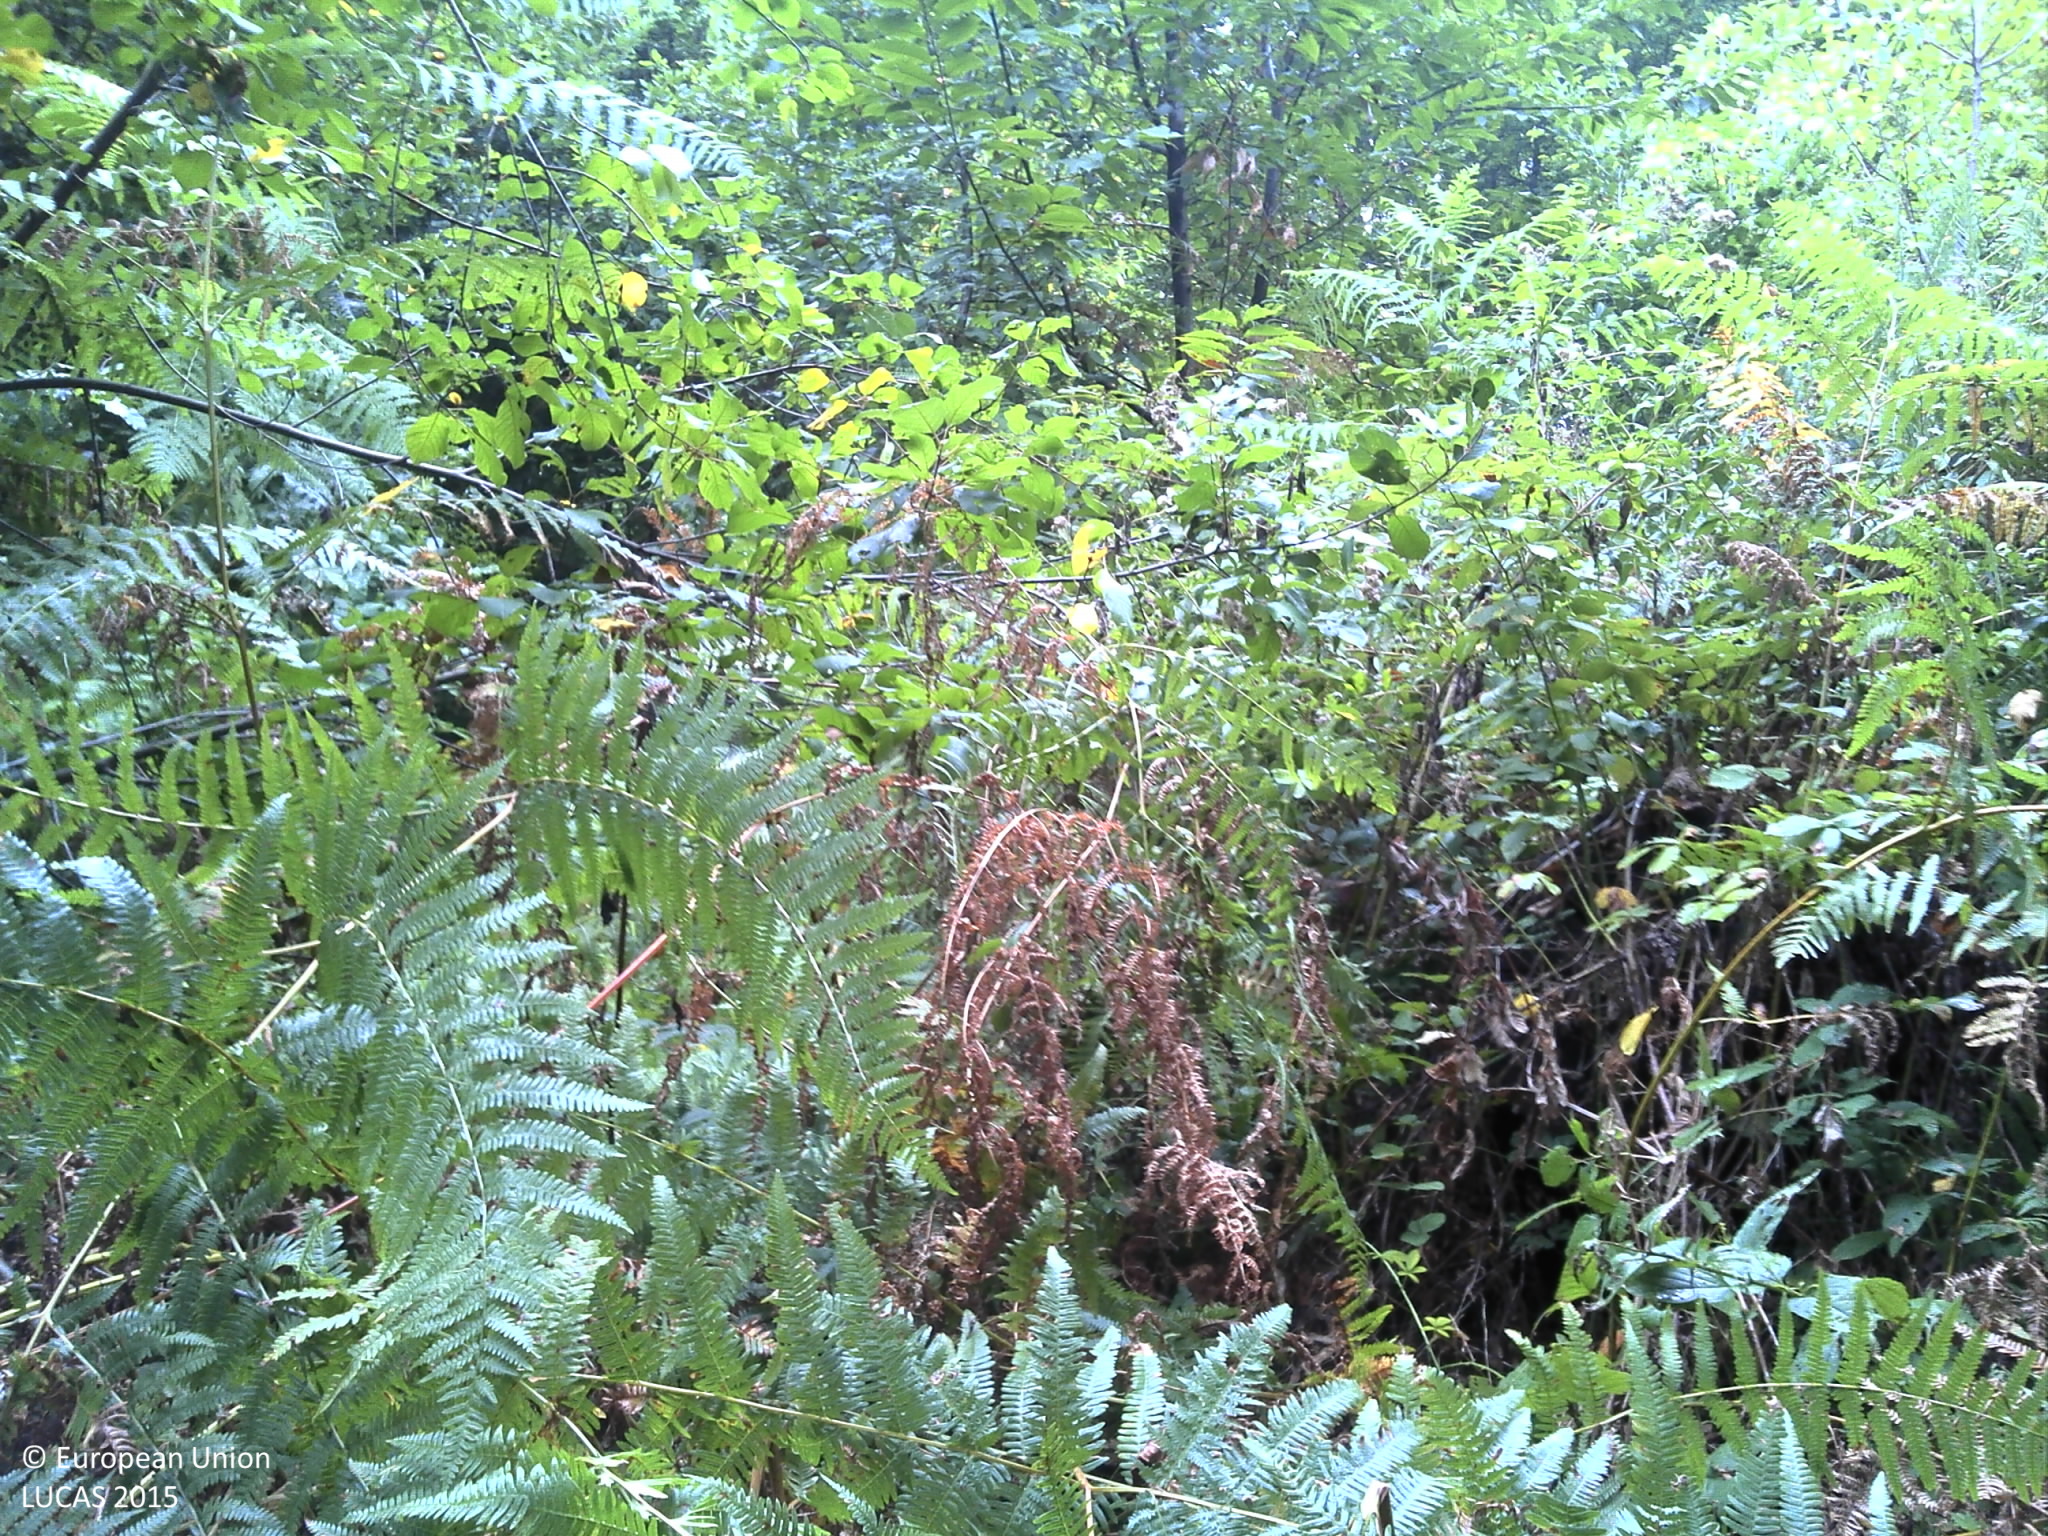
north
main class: Woodland
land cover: Broadleaved woodland
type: beech forest
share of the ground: > 75 %
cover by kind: broadleaved forest trees 100 %
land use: Forestry
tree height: > 5 m
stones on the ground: < 10 %
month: August
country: HR
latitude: 45.2450
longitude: 15.9714
